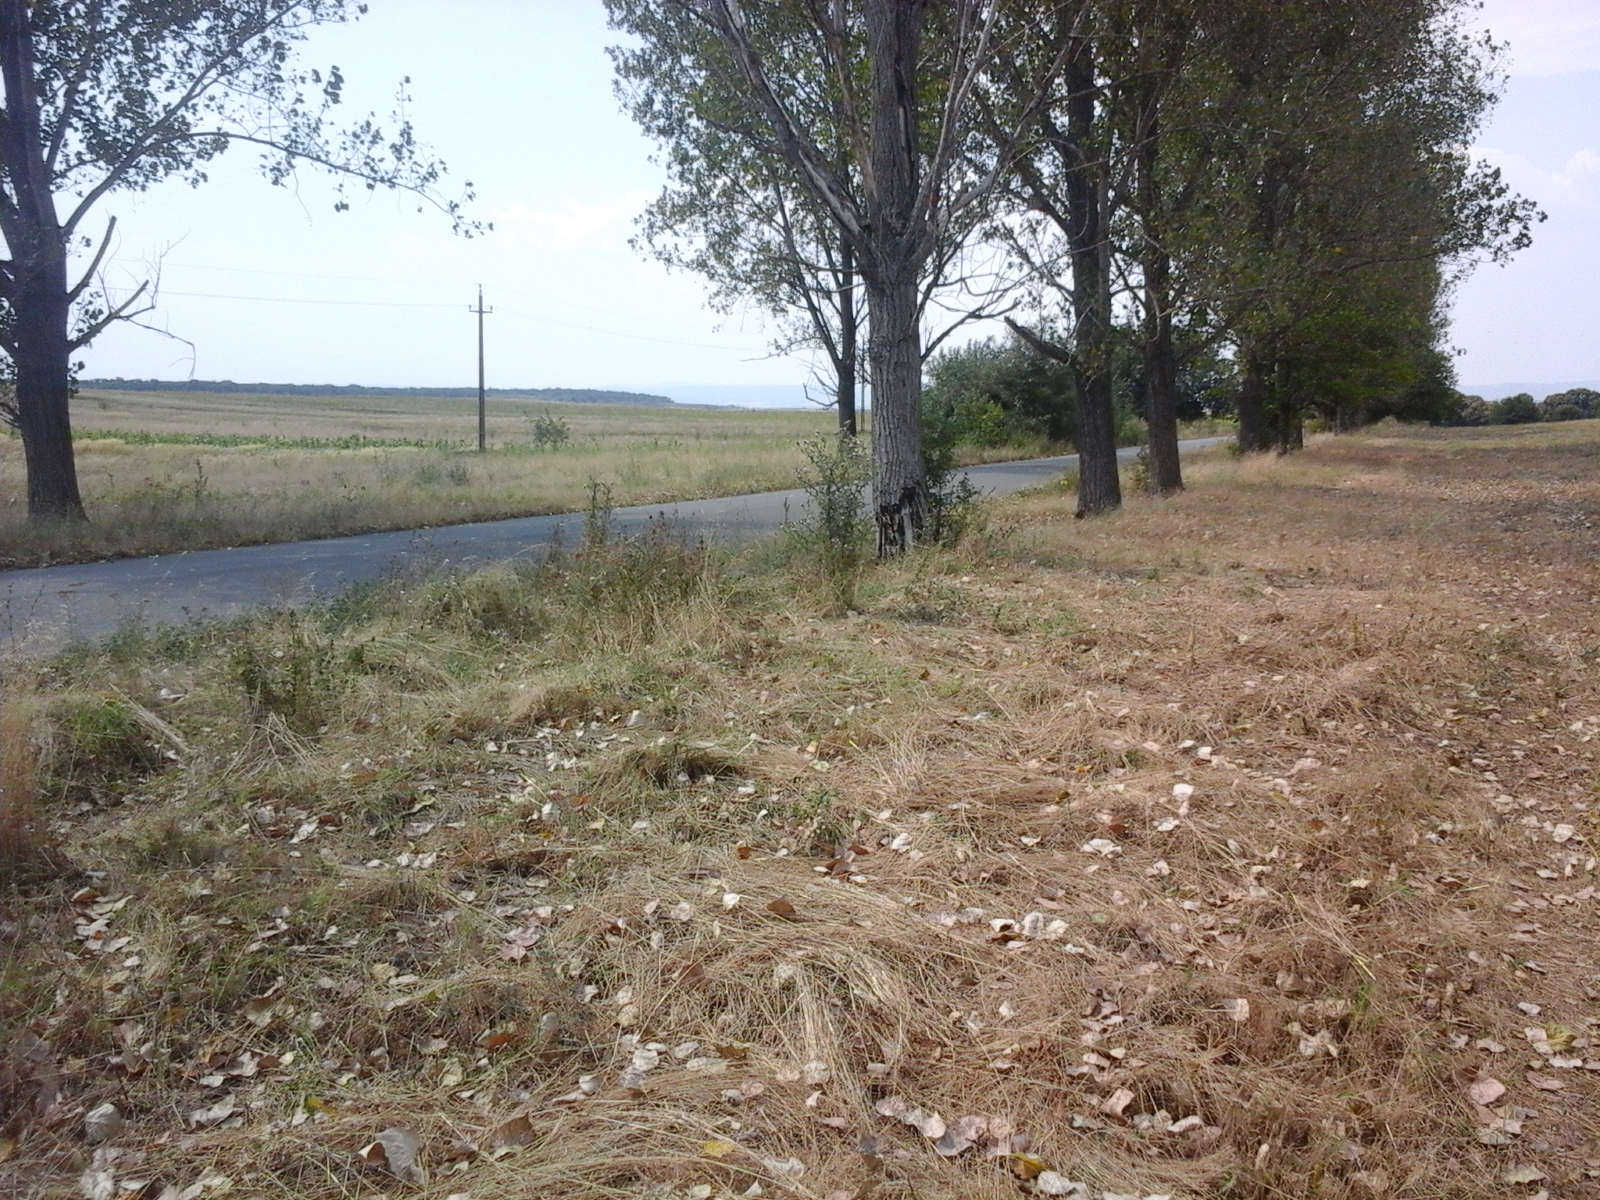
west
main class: Grassland
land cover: Grassland without tree/shrub cover
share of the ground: > 75 %
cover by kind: herbaceous plants 100 %
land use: Agriculture (excluding fallow land and kitchen gardens)
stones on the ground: < 10 %
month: August
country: RO
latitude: 44.5200
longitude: 22.6597
